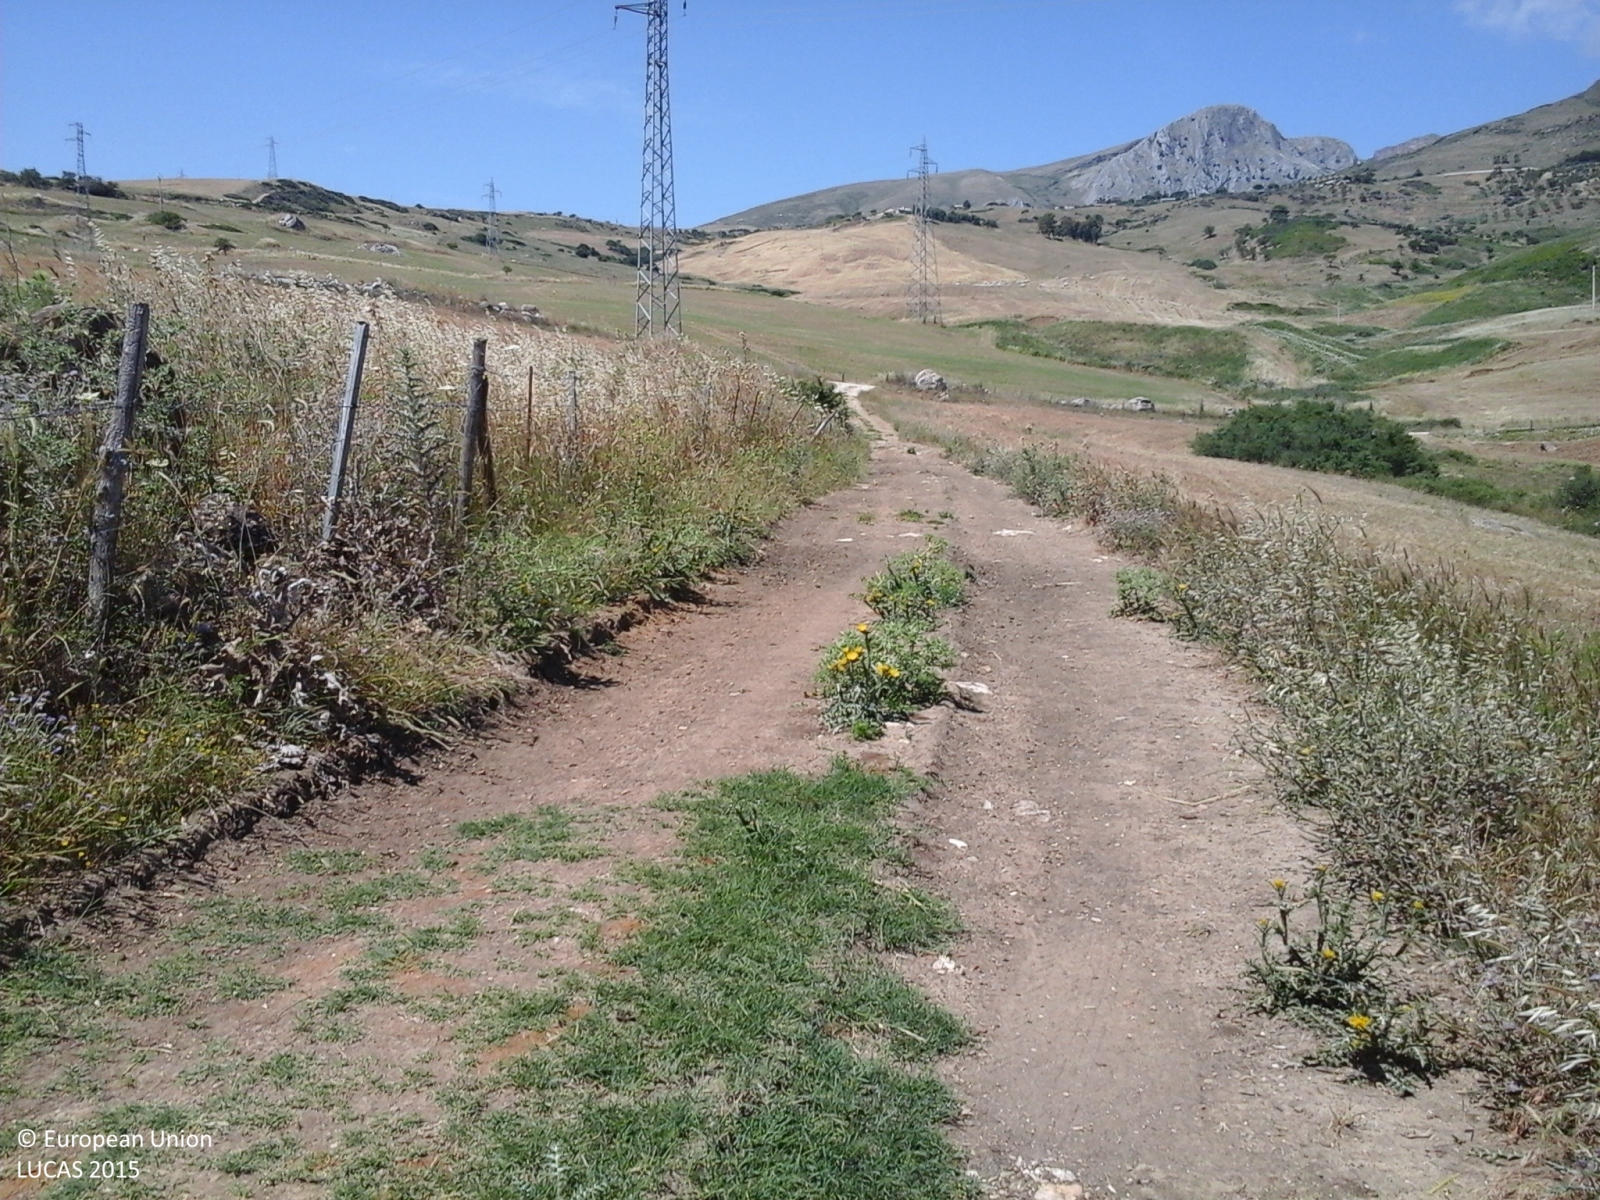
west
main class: Cropland
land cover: Durum wheat
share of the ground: > 75 %
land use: Agriculture (excluding fallow land and kitchen gardens)
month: June
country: IT
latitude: 37.8471
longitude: 13.4863
